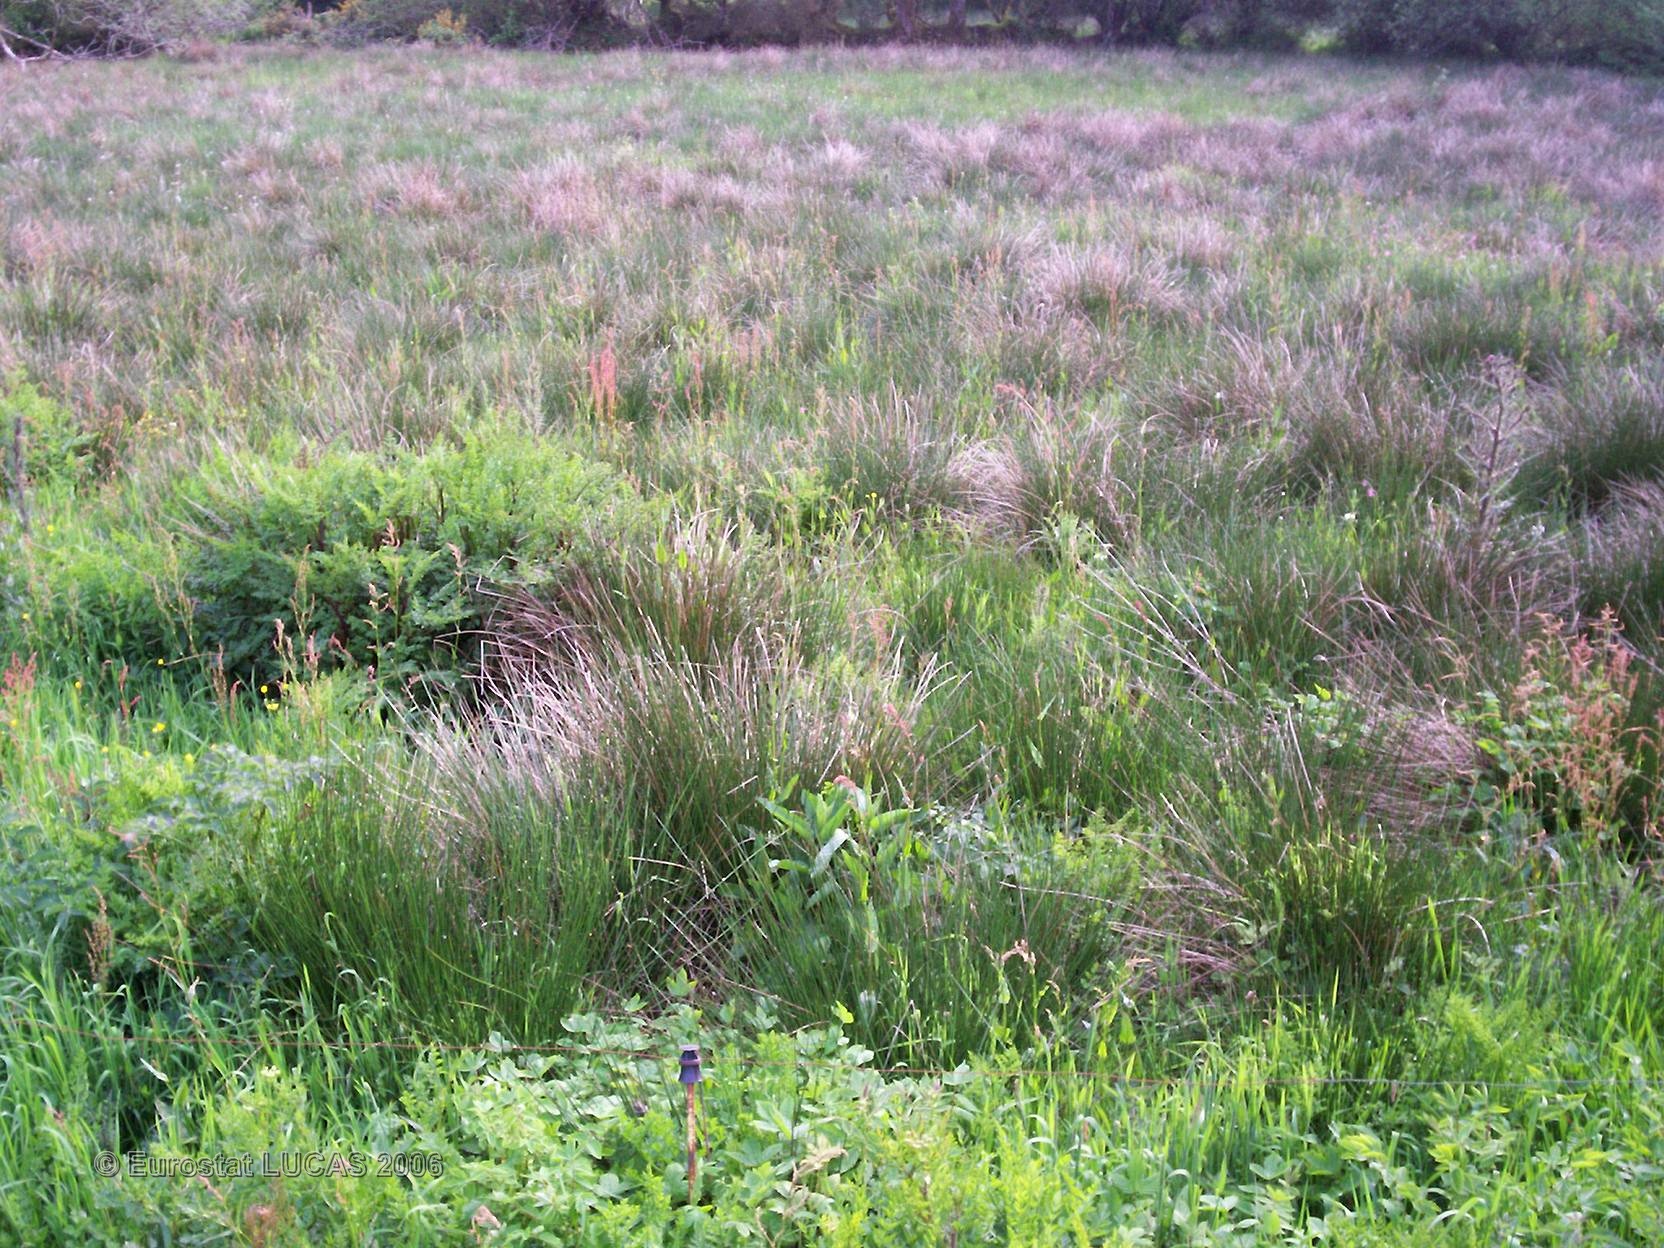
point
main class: Grassland
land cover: Grassland without tree/shrub cover
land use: Agriculture (excluding fallow land and kitchen gardens)
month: May
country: FR
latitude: 48.1568
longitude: -3.9185
